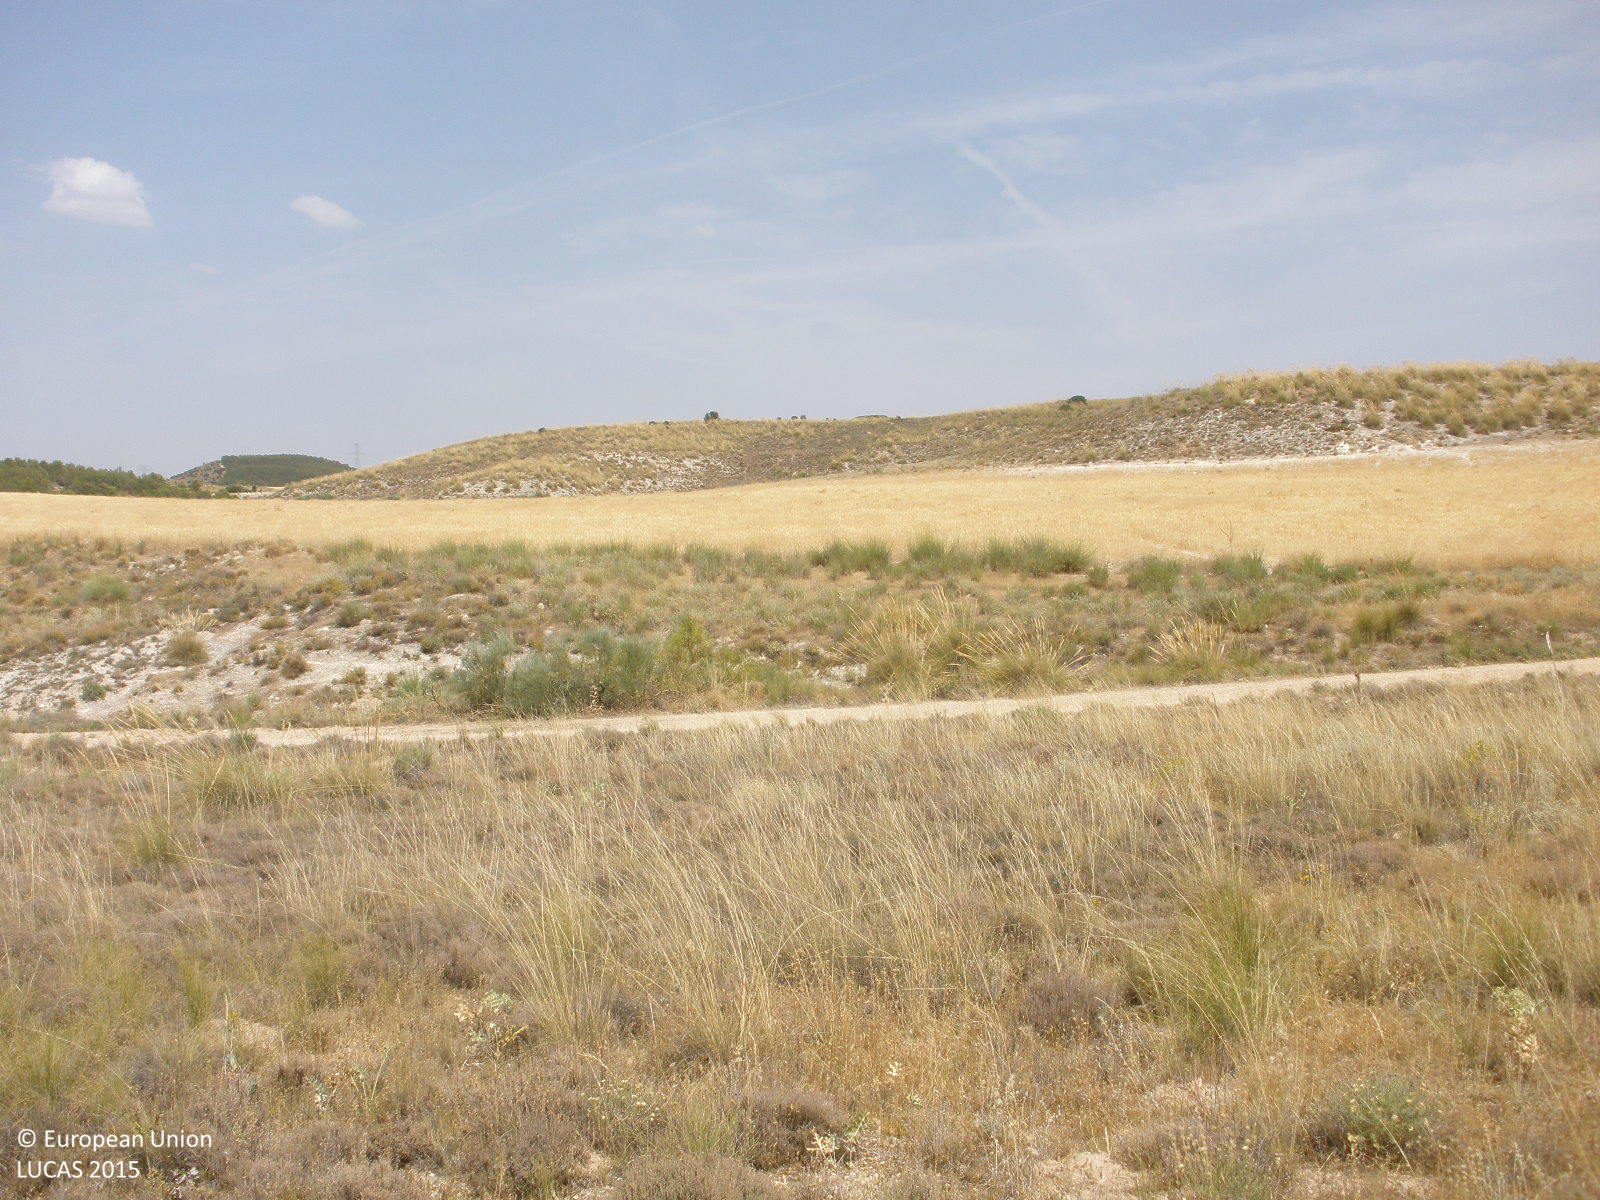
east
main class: Shrubland
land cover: Shrubland without tree cover
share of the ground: 10 - 25 %
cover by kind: herbaceous plants 70 %, shrubs 15 %, consolidated bare surface 15 %
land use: Semi-natural and natural areas not in use
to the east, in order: Shrubland without tree cover; Tracks; Shrubland without tree cover; Barley; Tracks; Barley; Shrubland without tree cover; Tracks; Shrubland without tree cover; Olive groves
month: July
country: ES
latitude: 40.1815
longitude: -3.4314
